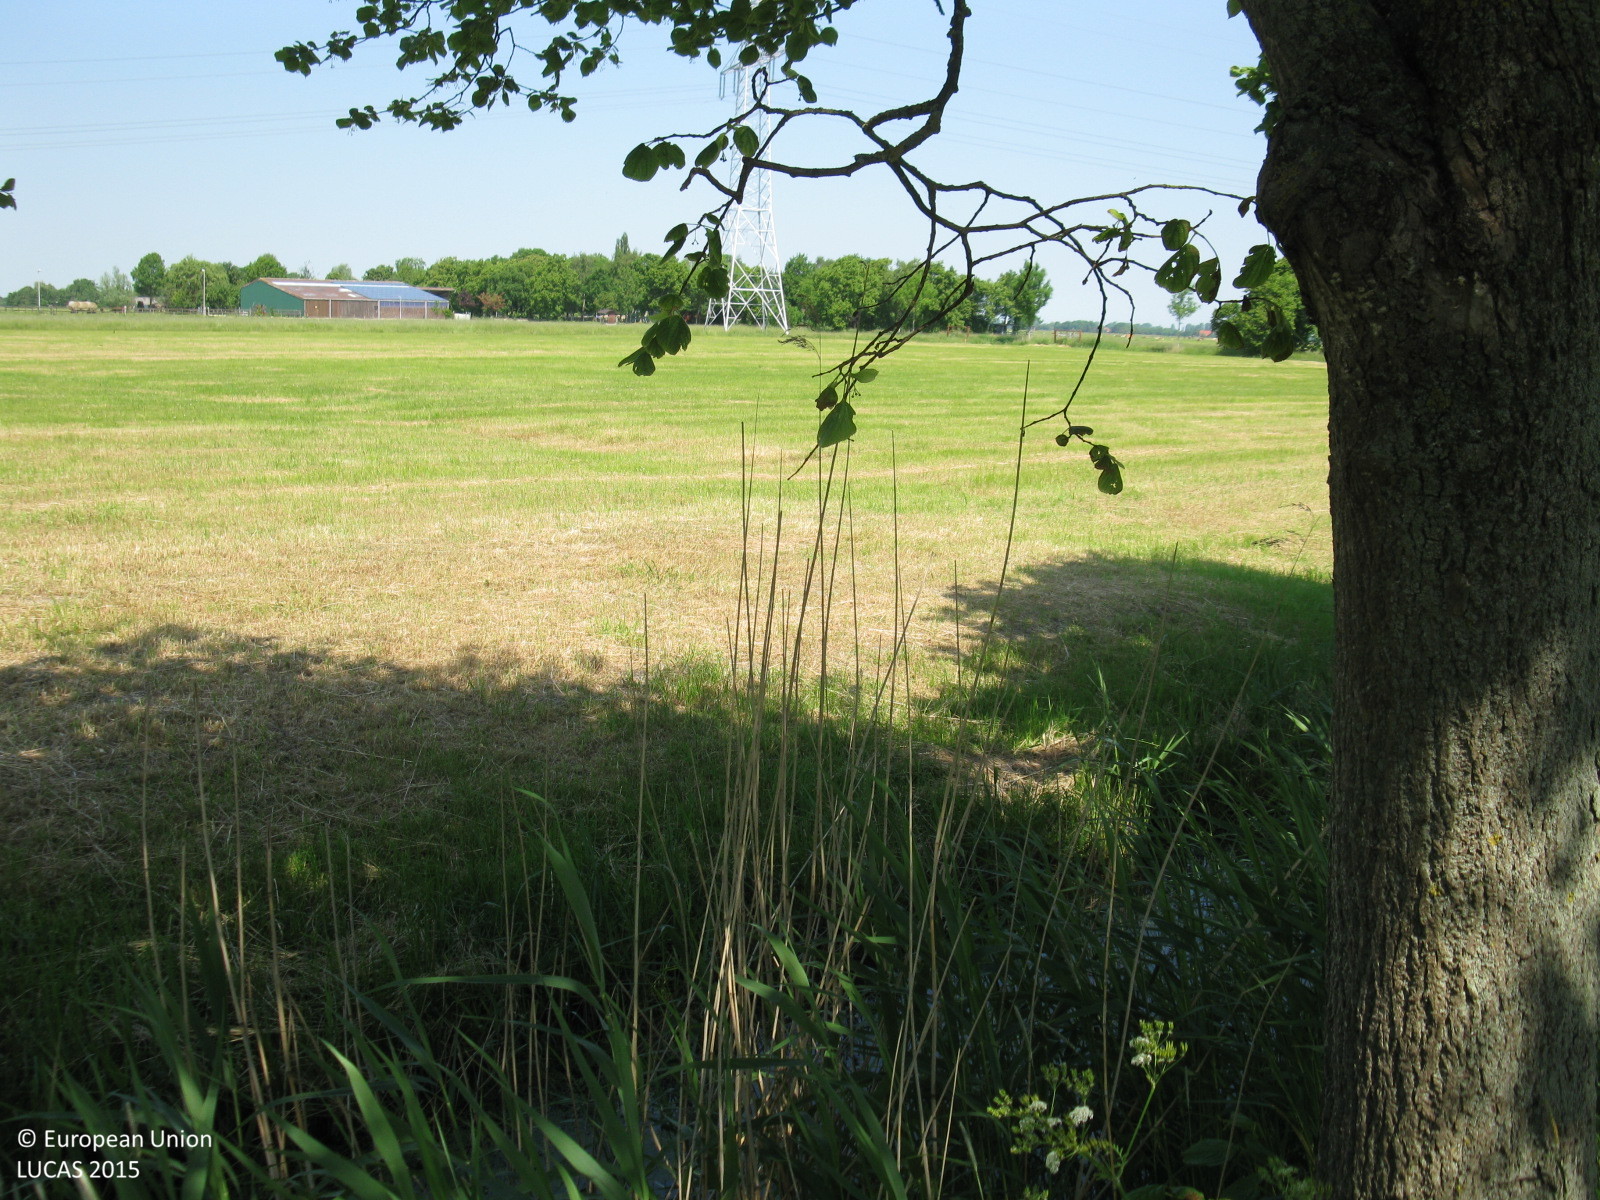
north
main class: Grassland
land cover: Grassland without tree/shrub cover
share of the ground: > 75 %
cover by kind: herbaceous plants 100 %
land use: Agriculture (excluding fallow land and kitchen gardens)
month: June
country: DE
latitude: 53.4998
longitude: 8.4479
